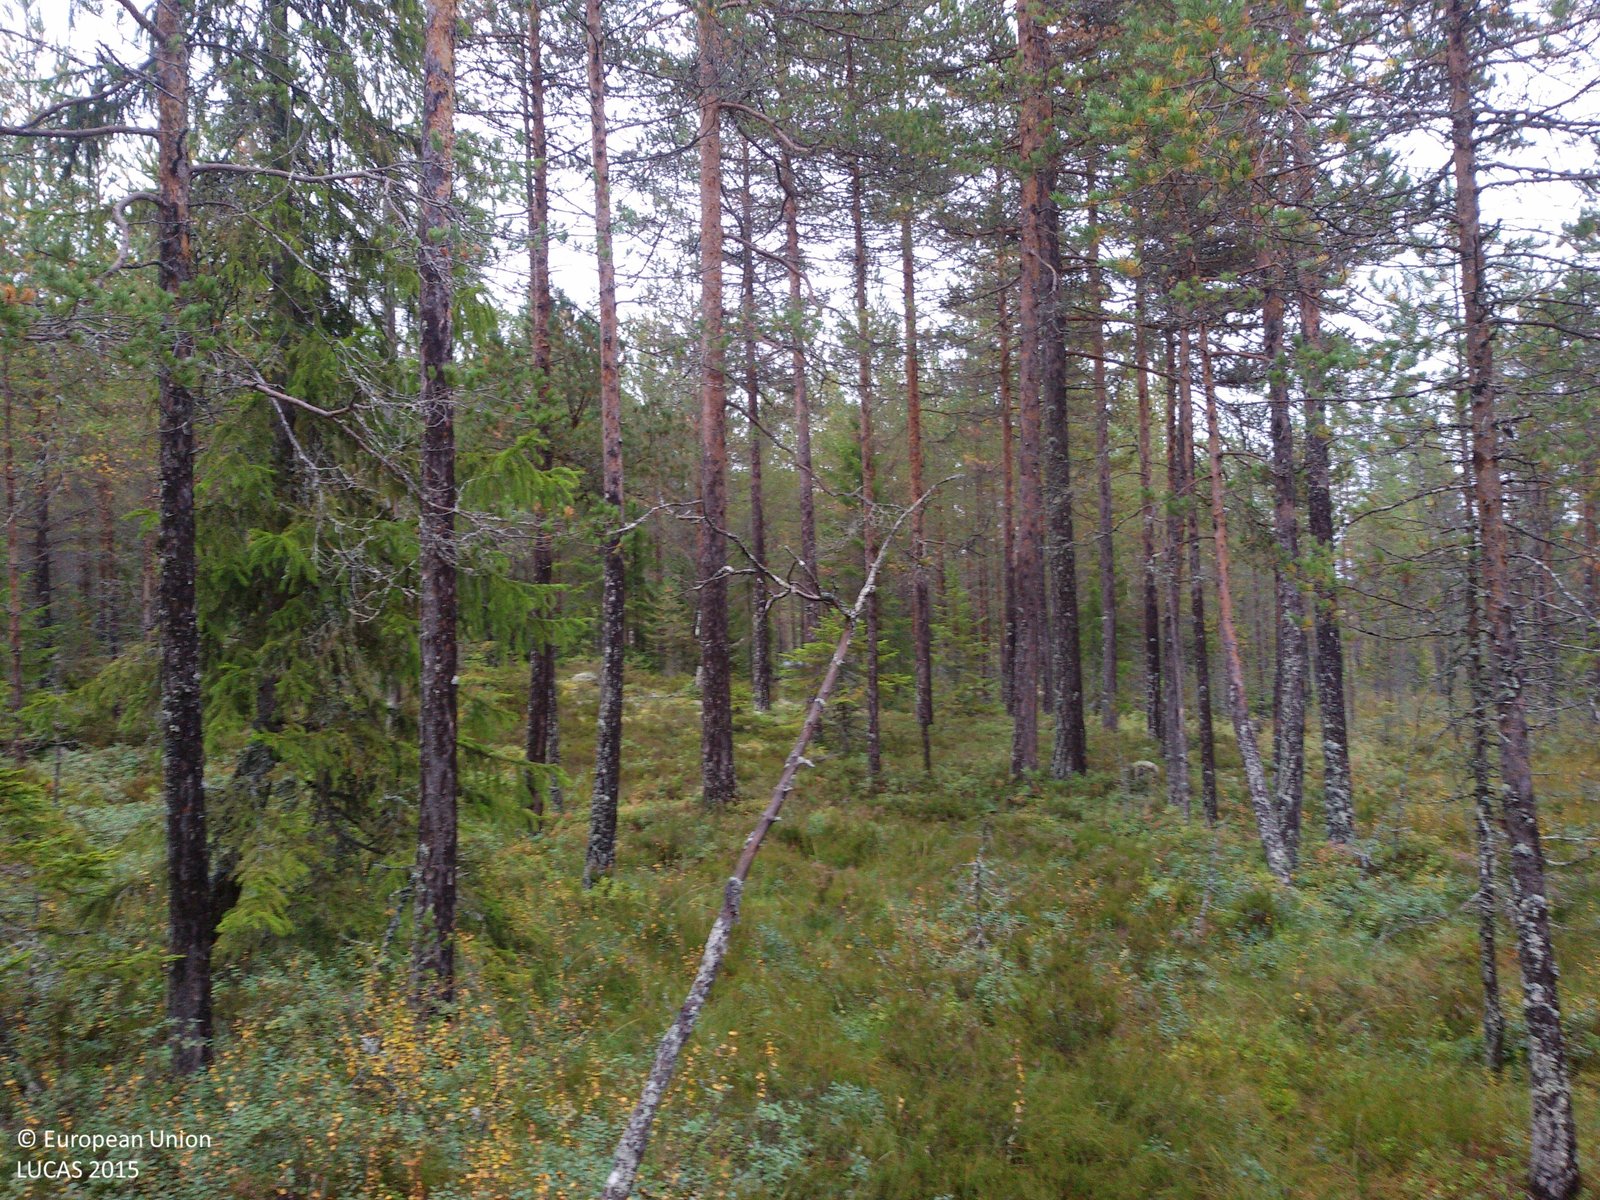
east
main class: Woodland
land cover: Pine dominated coniferous woodland
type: boreal forest
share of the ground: 50 - 75 %
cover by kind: coniferous forest trees 60 %, herbaceous plants 20 %, lichens and mosses 20 %
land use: Forestry
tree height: > 5 m
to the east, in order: Pine dominated coniferous woodland; Paved roads, cycling and walking lanes; Pine dominated coniferous woodland; Pine dominated mixed woodland; Rivers and streams; Pine dominated mixed woodland
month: September
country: SE
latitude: 60.9293
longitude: 14.2123
